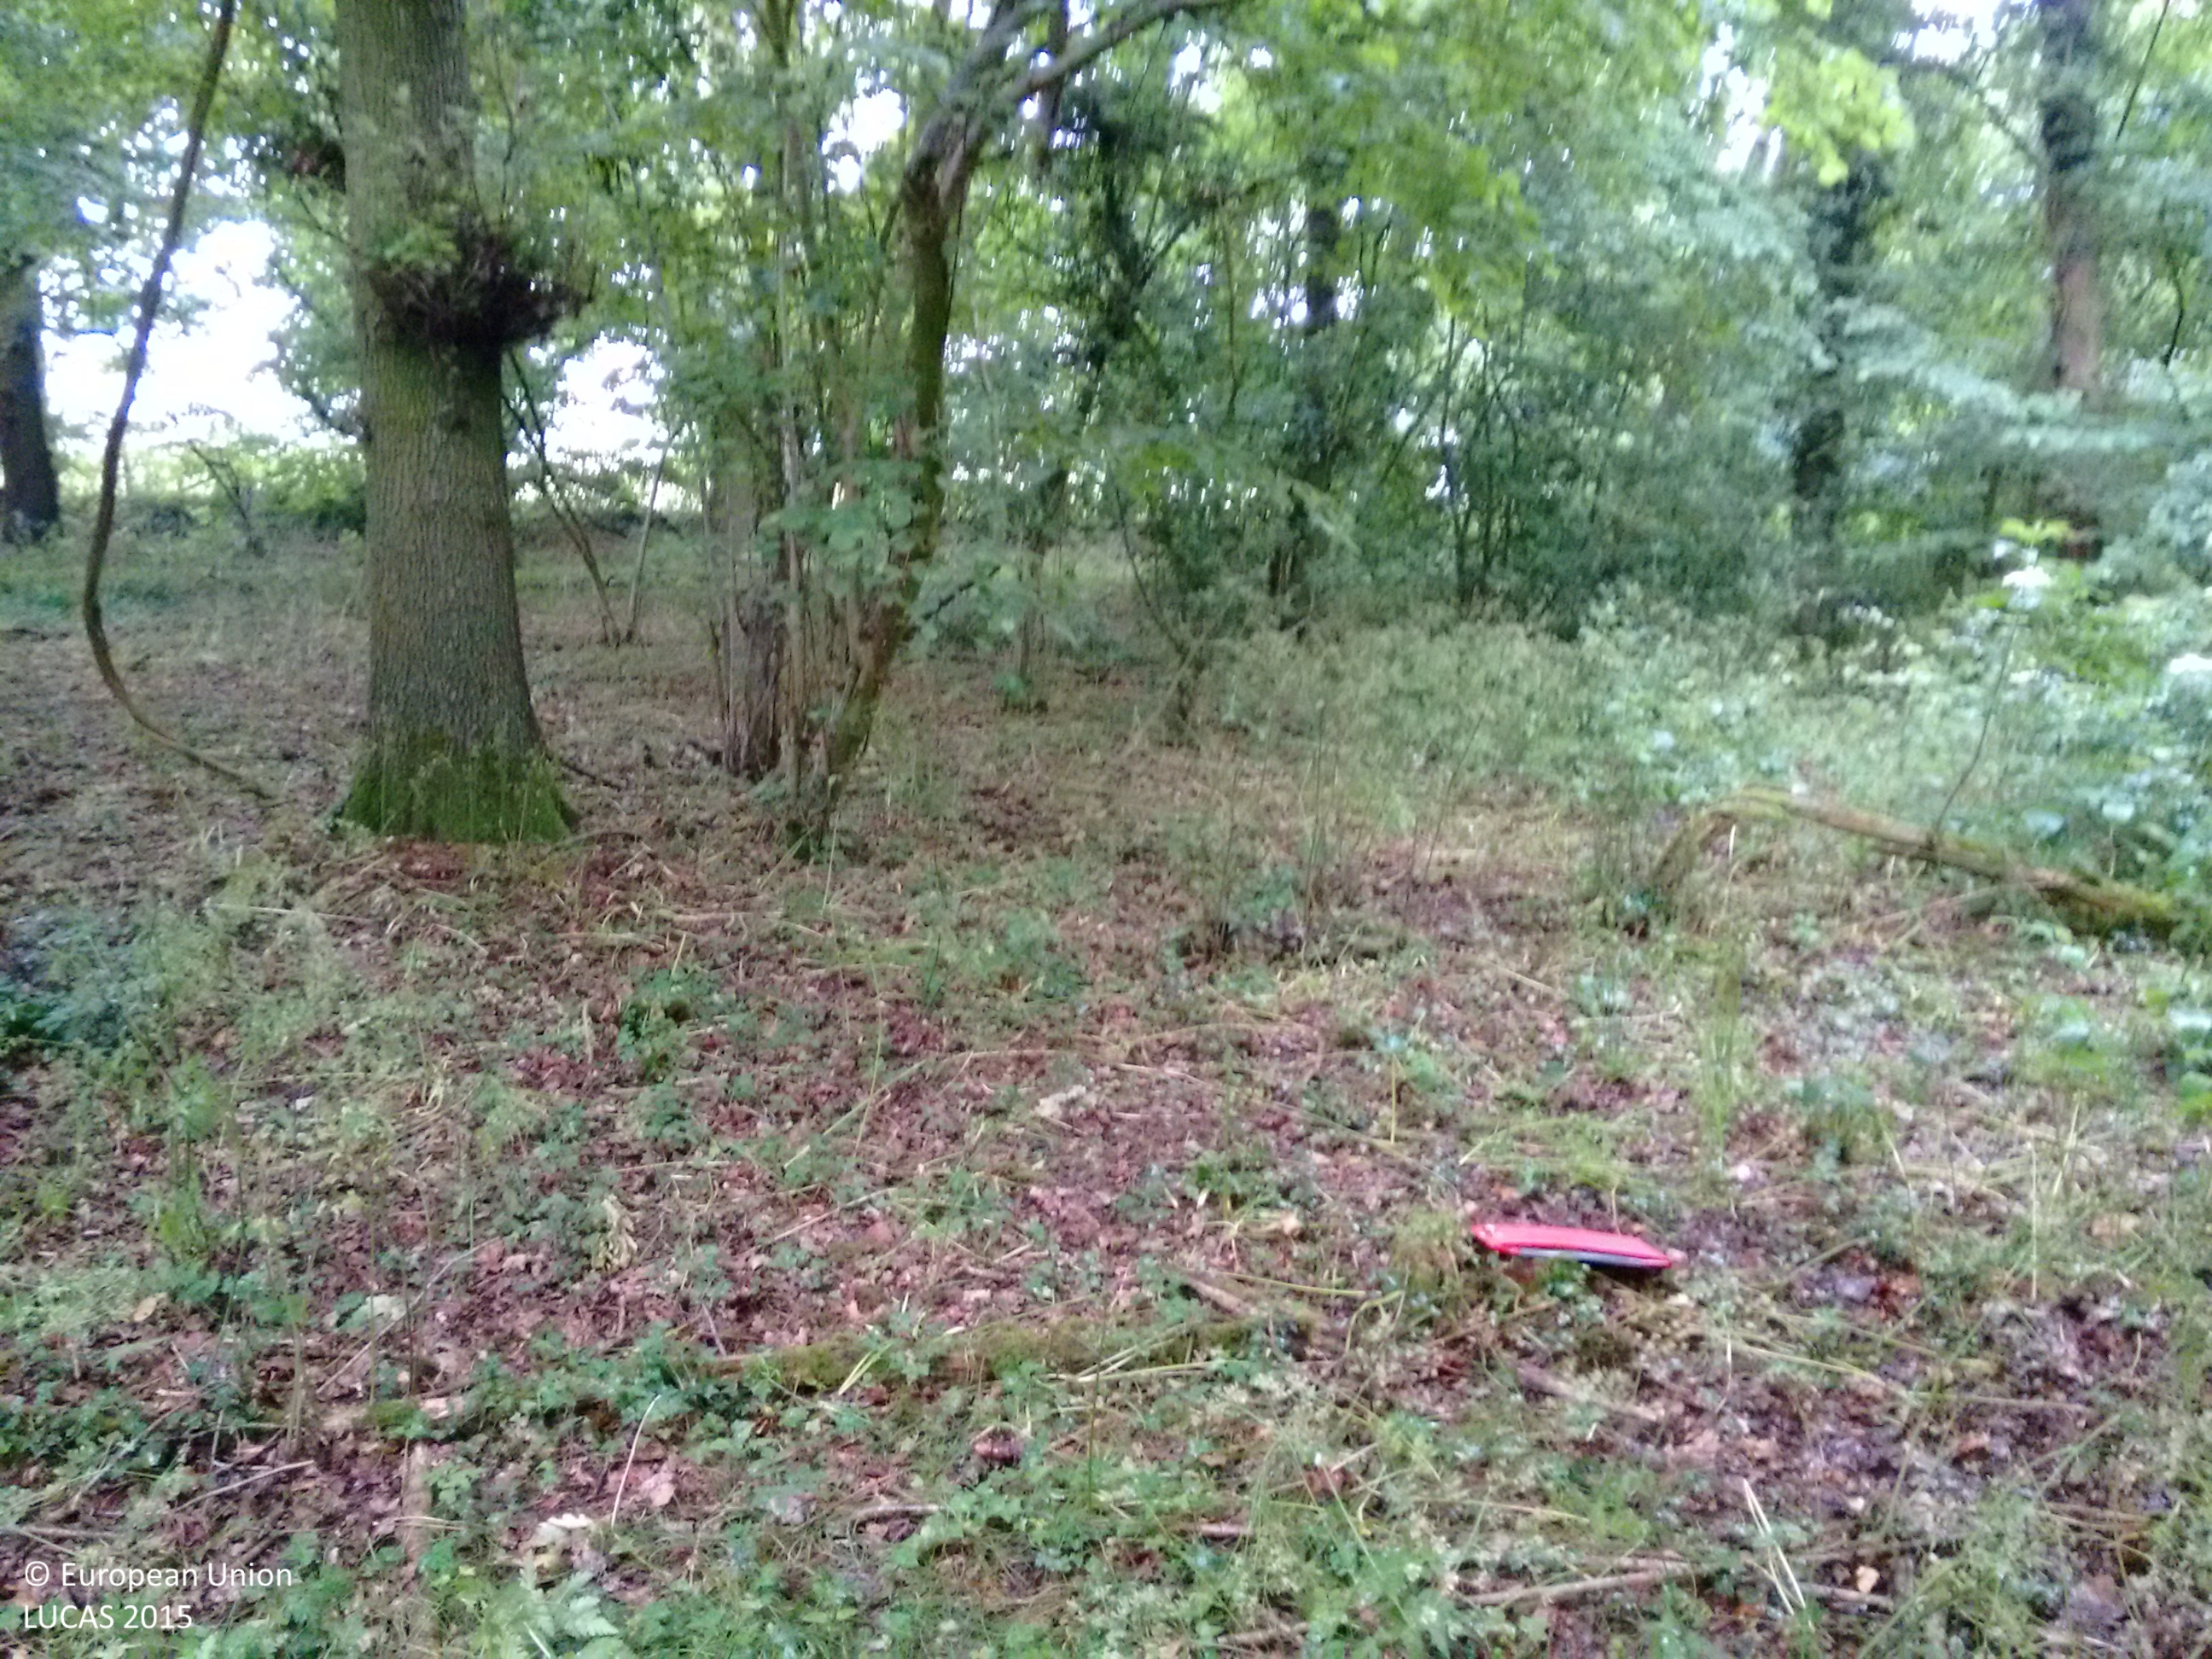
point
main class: Woodland
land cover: Broadleaved woodland
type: mesophytic deciduous forest
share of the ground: > 75 %
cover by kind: broadleaved forest trees 95 %, herbaceous plants 5 %
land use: Forestry
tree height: > 5 m
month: June
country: GB
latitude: 51.5105
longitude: -1.0973
